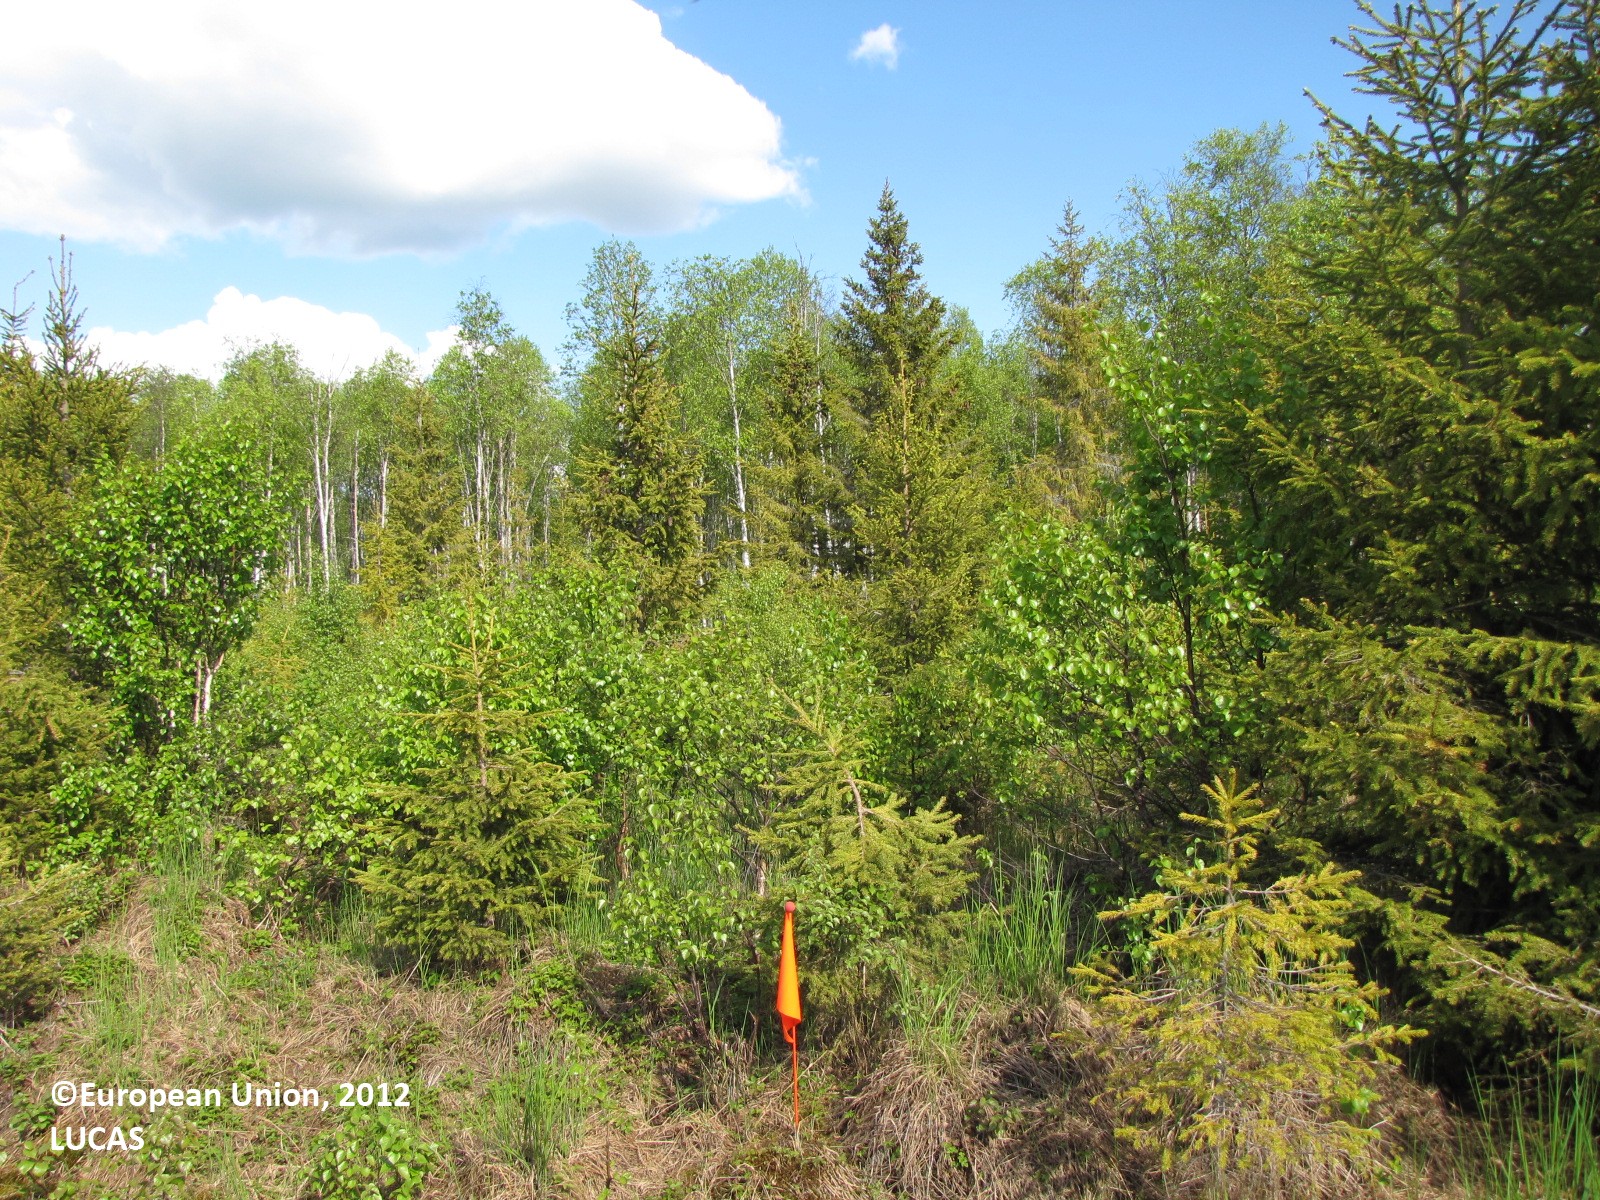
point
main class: Woodland
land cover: Other mixed woodland
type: boreal forest
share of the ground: 50 - 75 %
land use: Forestry
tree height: < 5 m
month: June
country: FI
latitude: 66.0121
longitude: 24.5343
